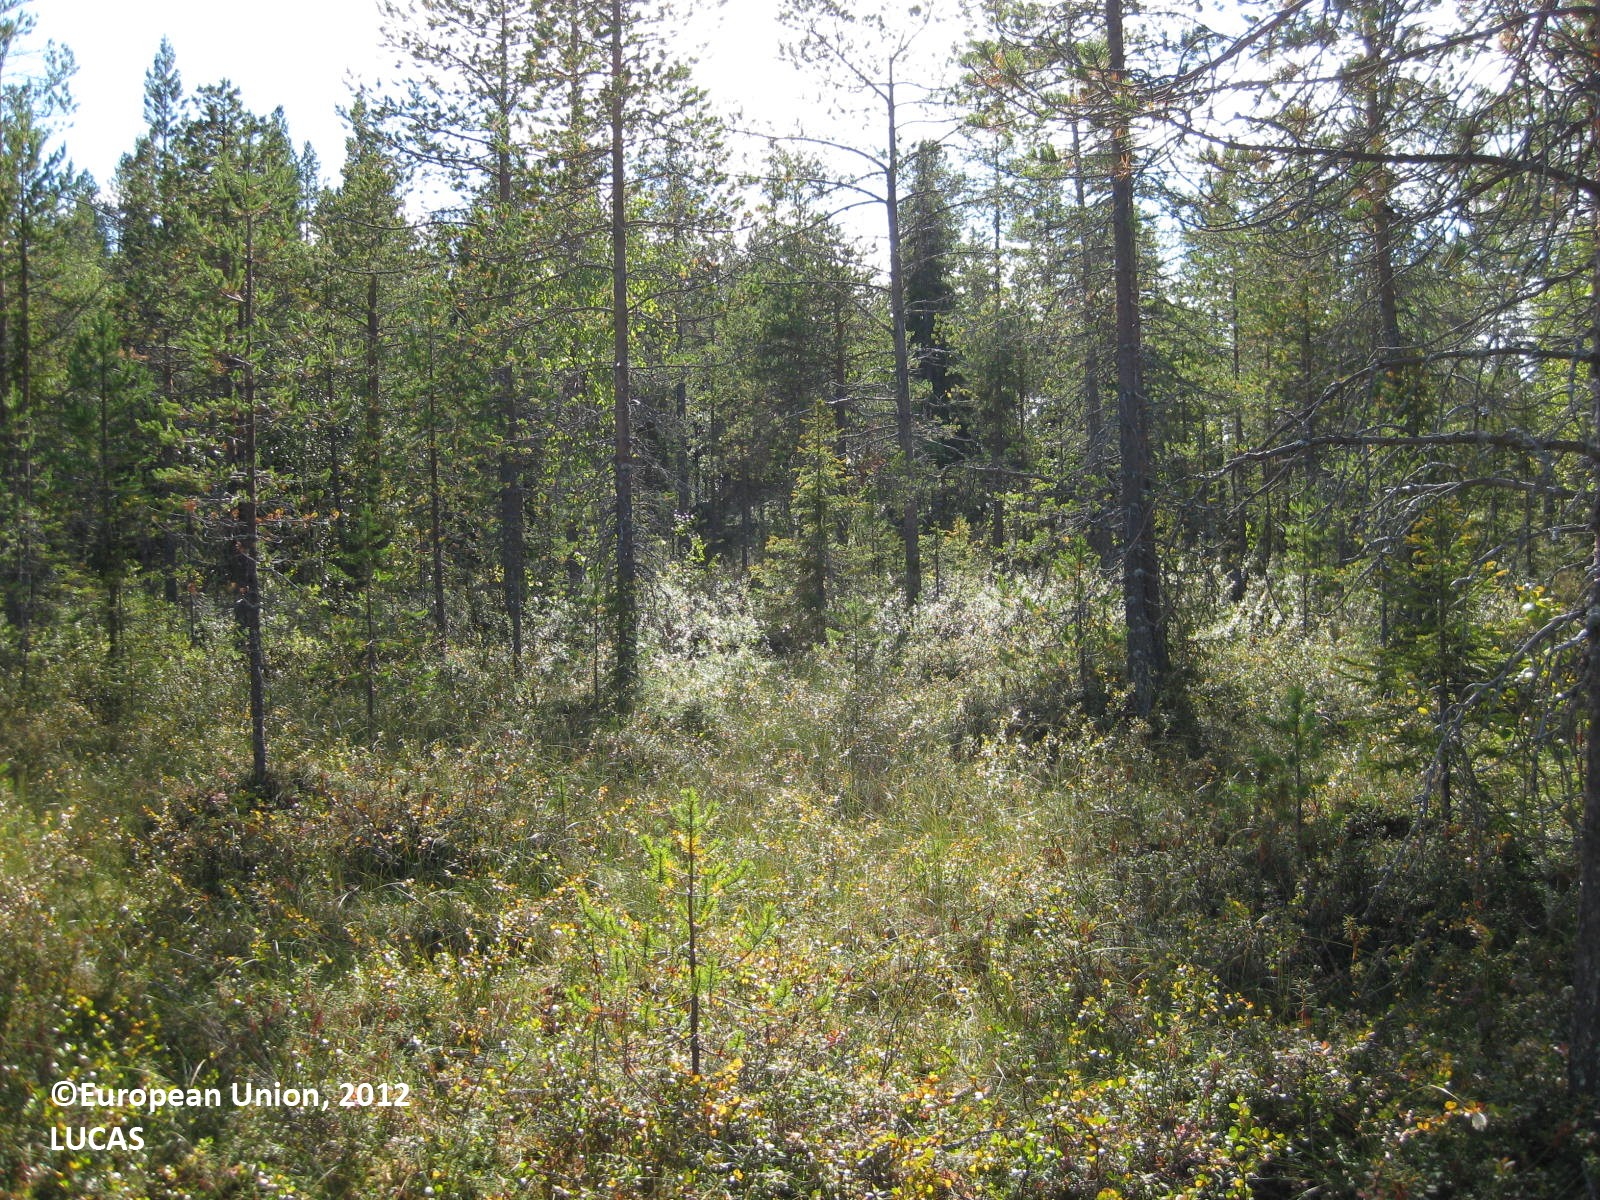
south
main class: Woodland
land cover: Pine dominated coniferous woodland
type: boreal forest
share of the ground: 50 - 75 %
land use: Forestry
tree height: > 5 m
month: August
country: FI
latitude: 66.0642
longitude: 29.6097
